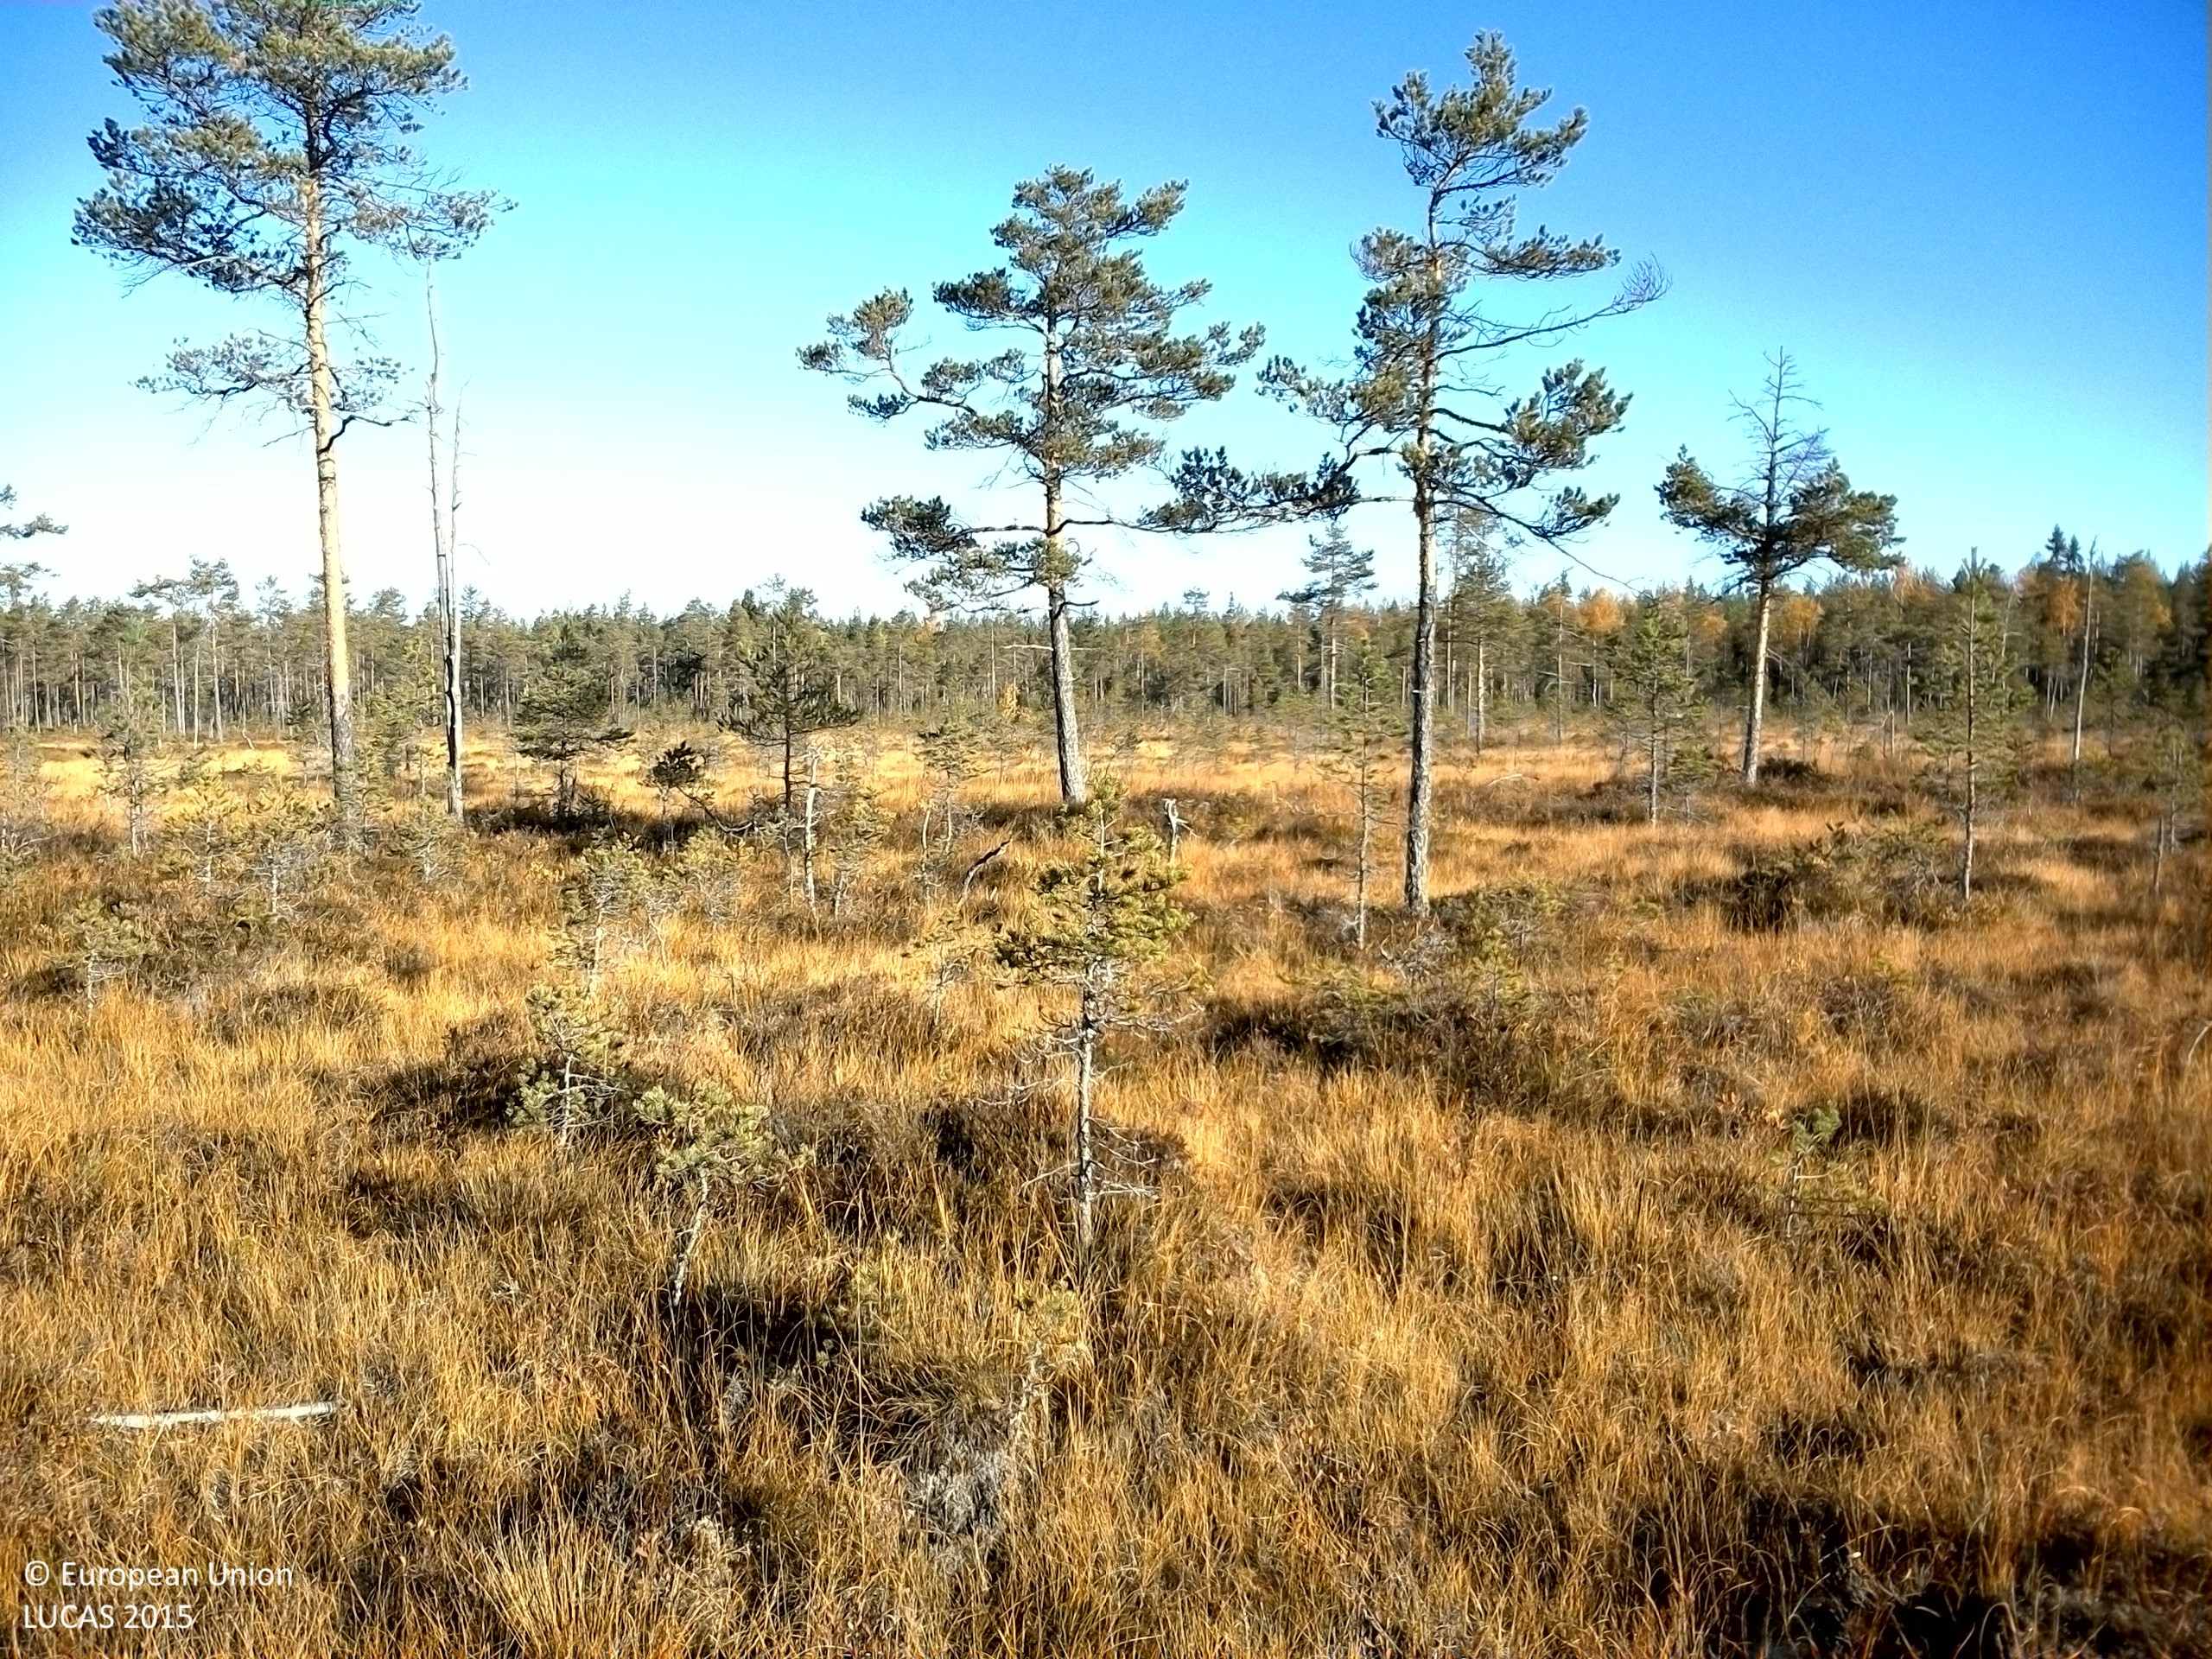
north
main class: Woodland
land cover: Pine dominated coniferous woodland
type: boreal forest
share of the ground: 10 - 25 %
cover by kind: shrubs 40 %, coniferous forest trees 20 %, herbaceous plants 20 %, lichens and mosses 20 %
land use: Forestry
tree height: < 5 m
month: October
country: SE
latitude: 61.1994
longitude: 15.3256
